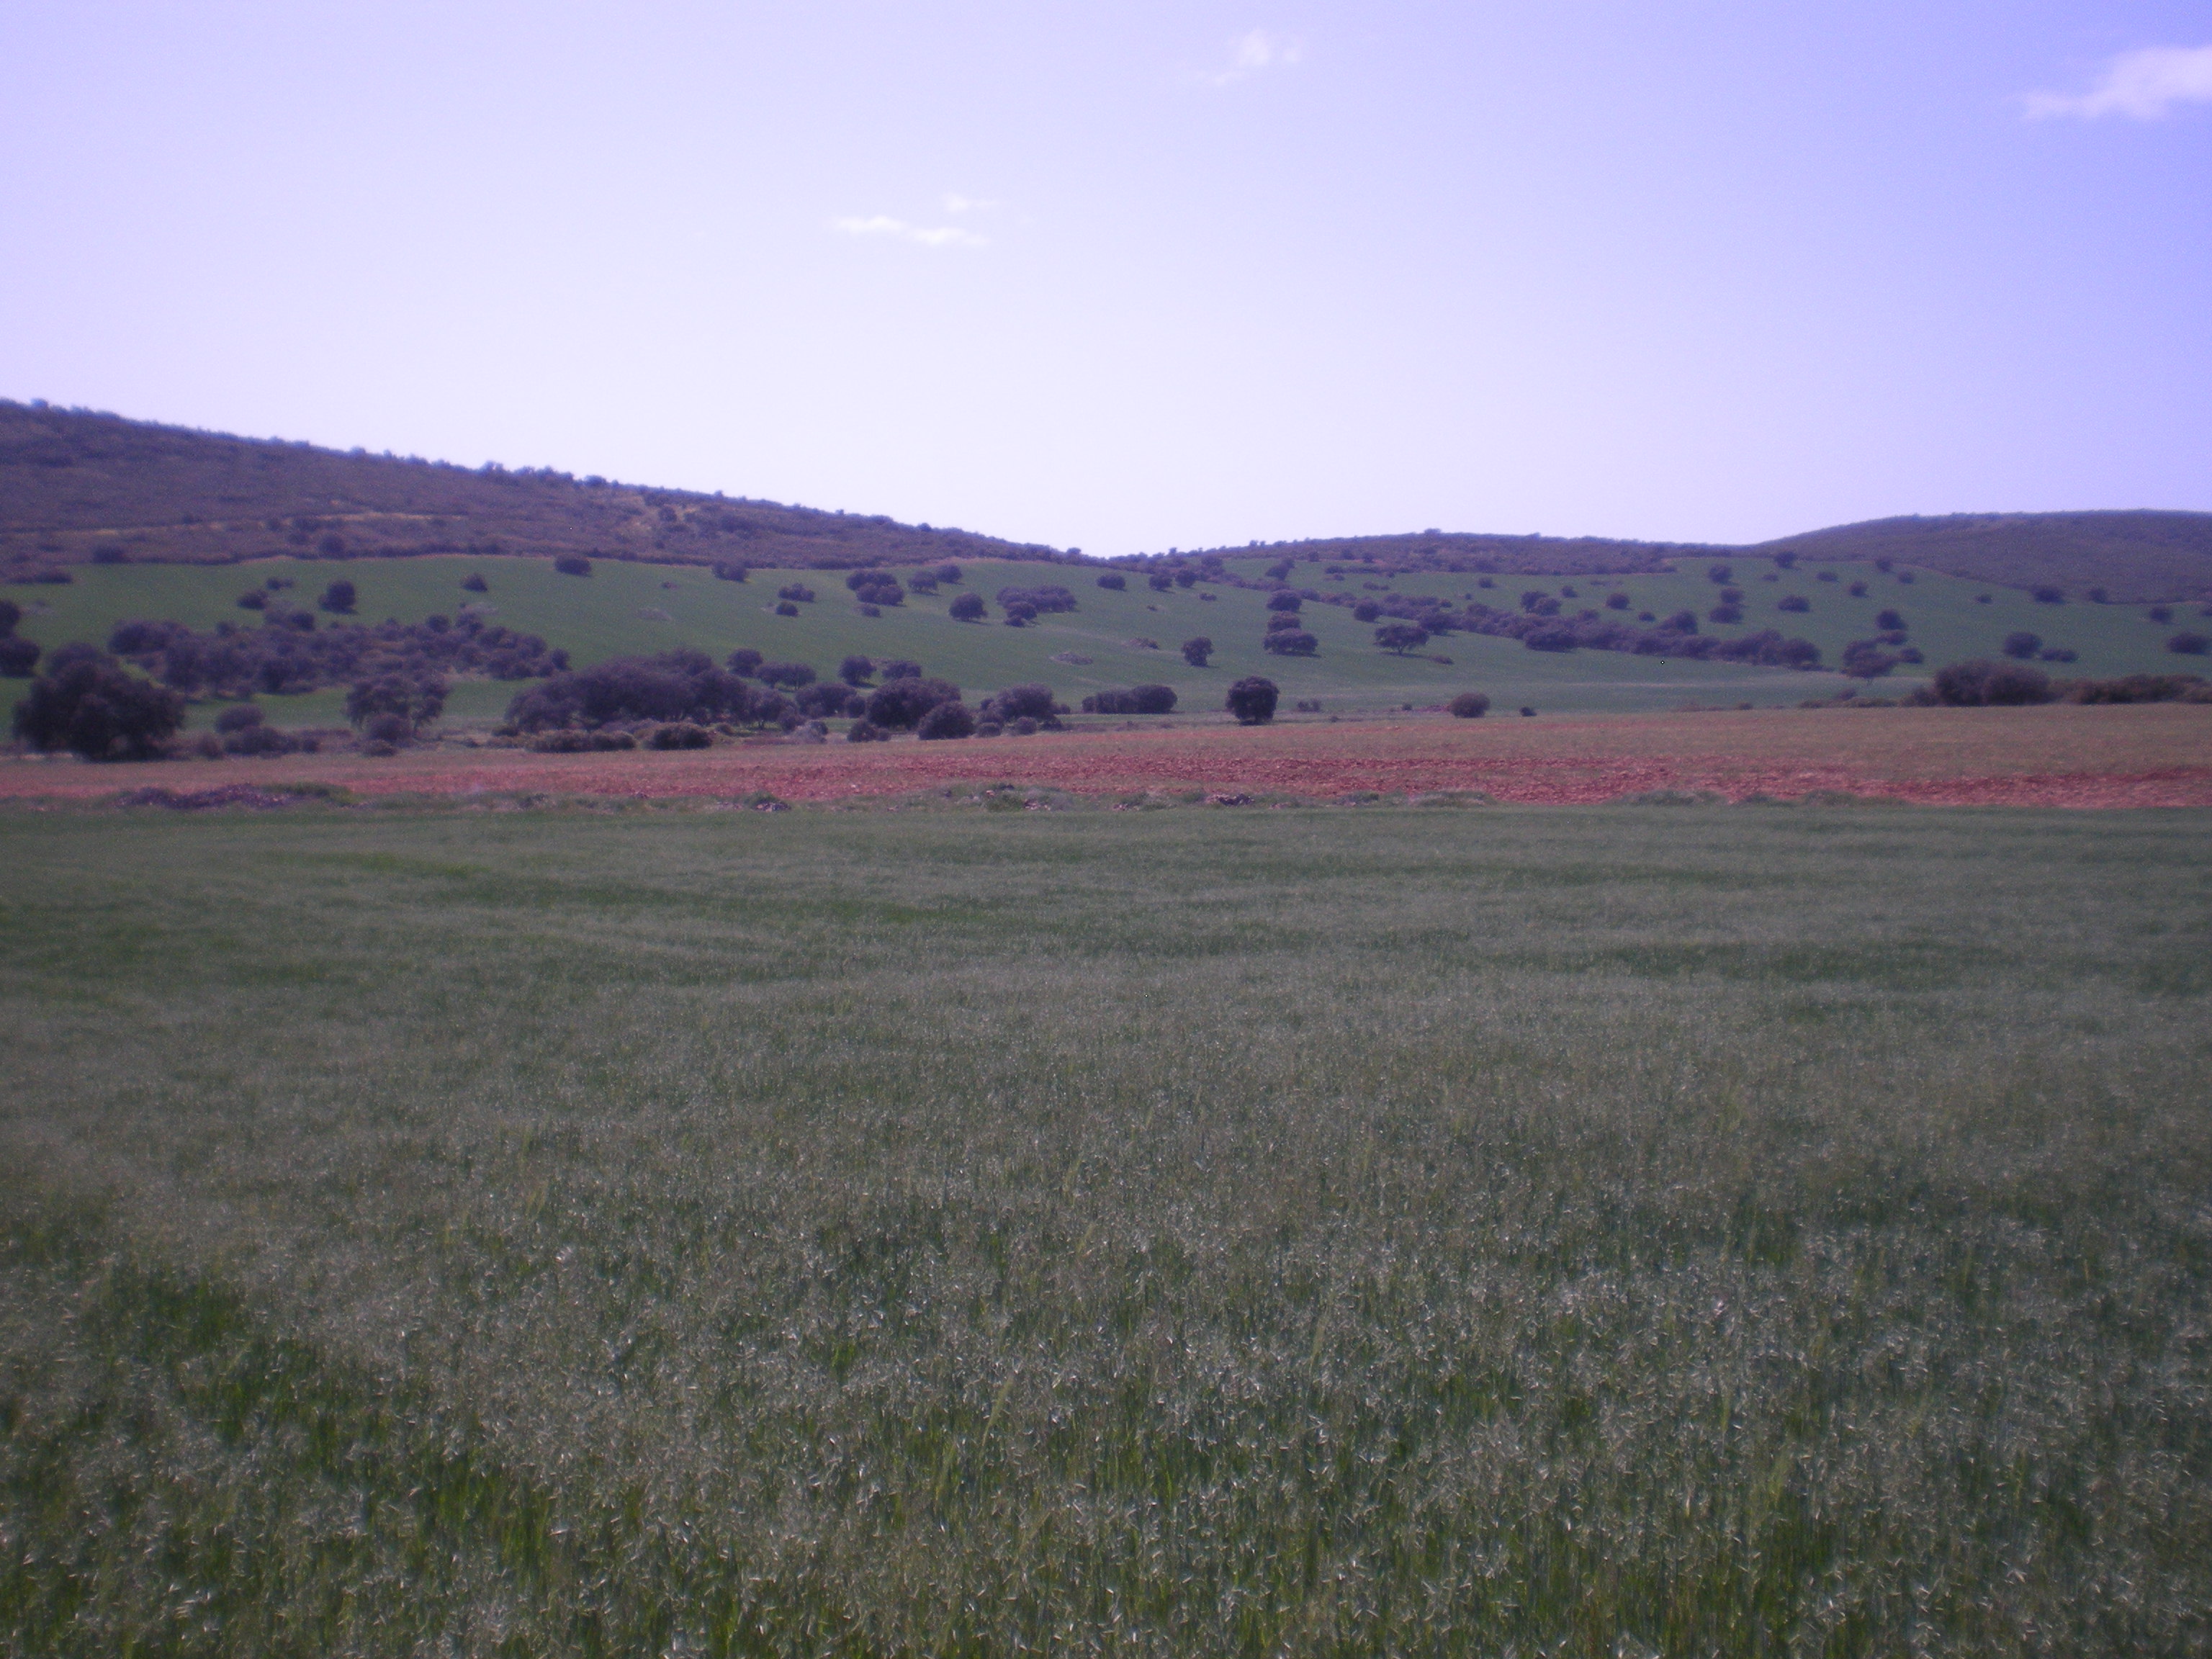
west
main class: Cropland
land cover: Oats
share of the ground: > 75 %
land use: Agriculture (excluding fallow land and kitchen gardens)
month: April
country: ES
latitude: 38.6288
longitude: -3.5307
